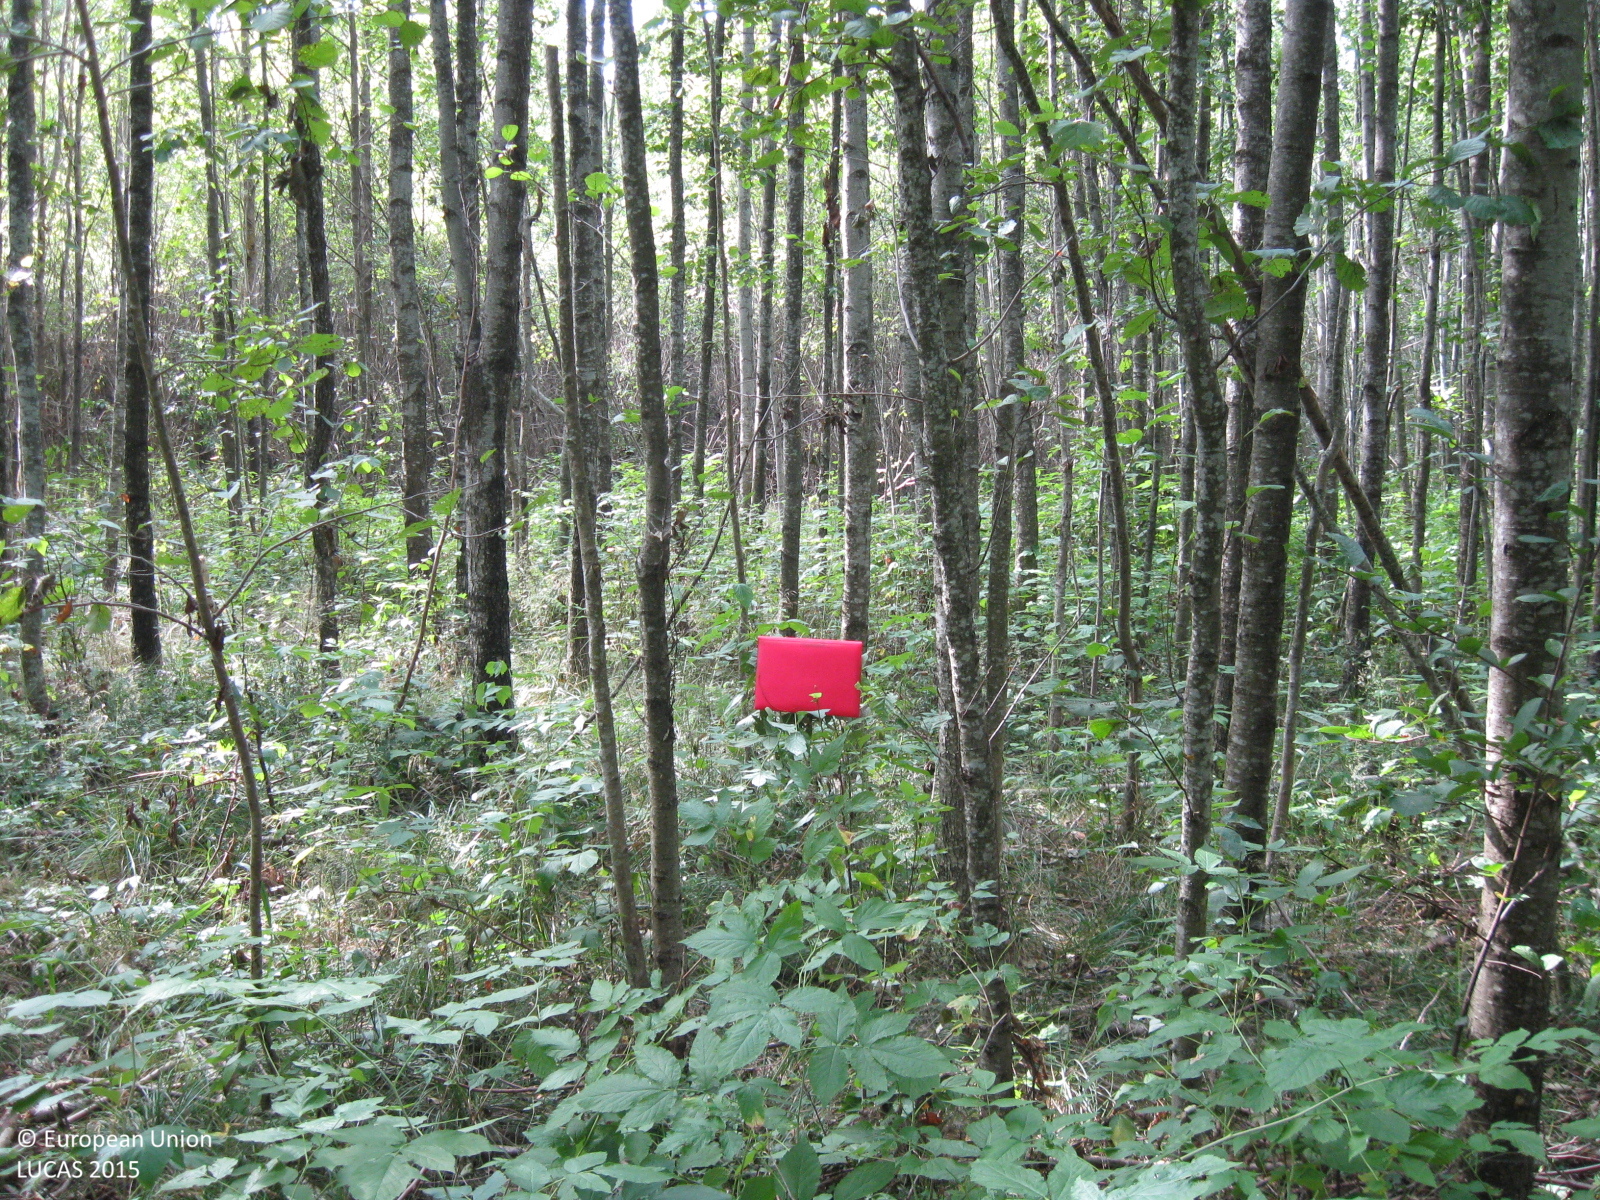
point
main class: Woodland
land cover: Broadleaved woodland
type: non-riverine alder, birch or aspen forest
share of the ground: > 75 %
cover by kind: broadleaved forest trees 90 %, shrubs 5 %, herbaceous plants 5 %
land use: Forestry
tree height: > 5 m
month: August
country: LT
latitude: 55.4185
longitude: 23.2984
